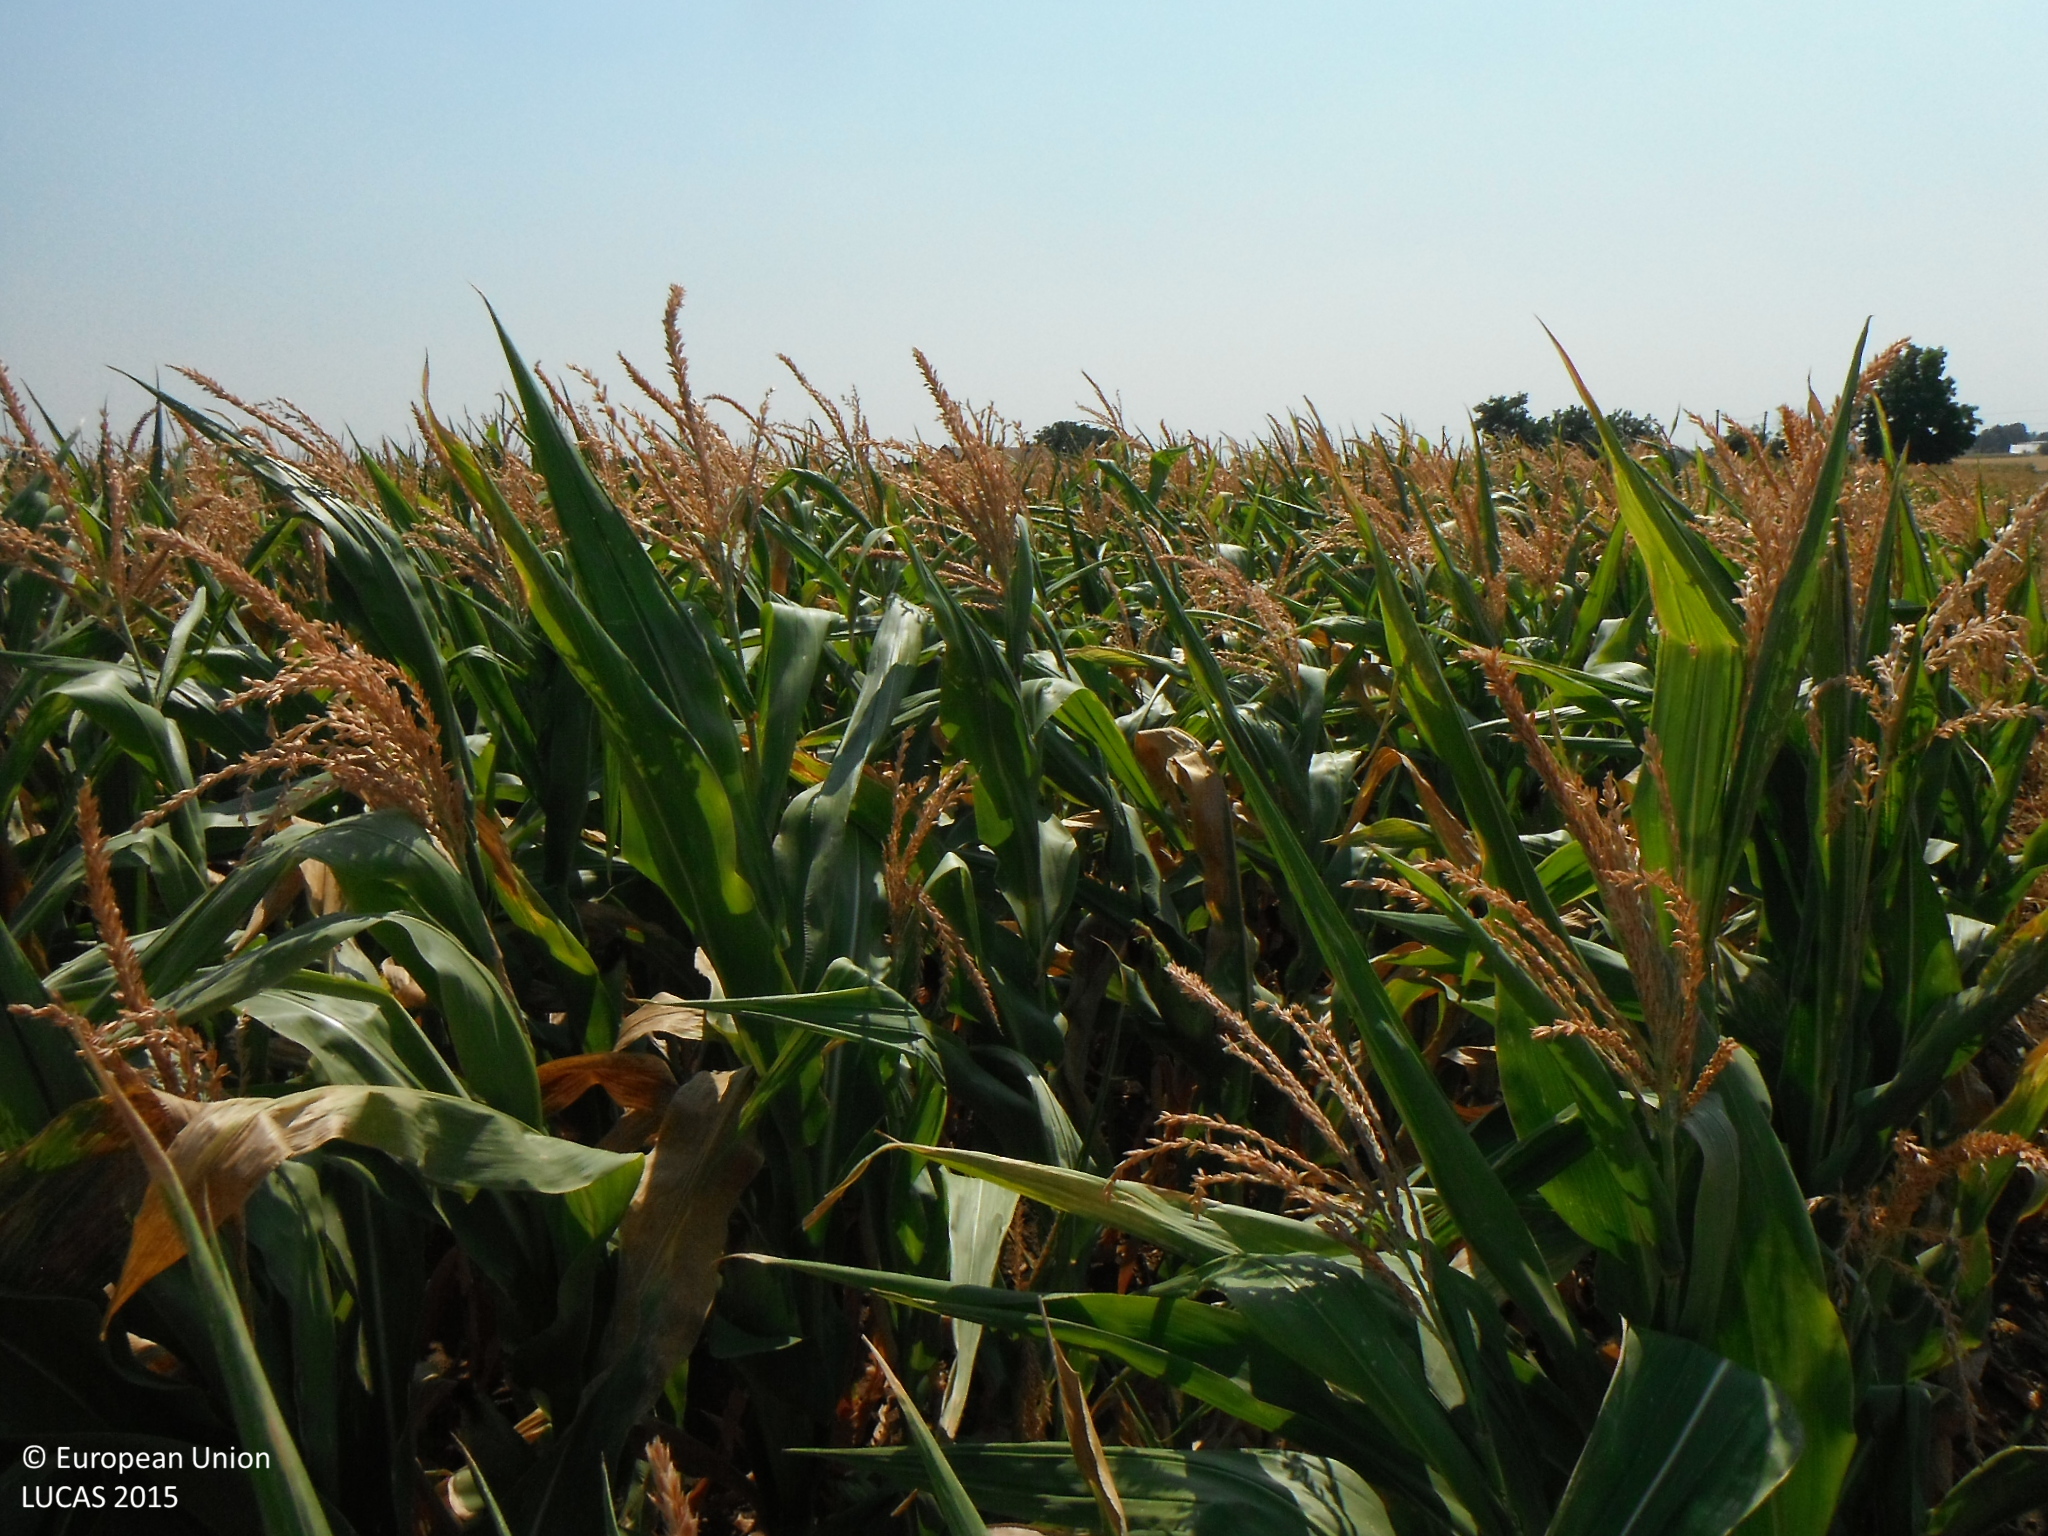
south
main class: Cropland
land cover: Maize
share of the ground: > 75 %
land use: Agriculture (excluding fallow land and kitchen gardens)
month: August
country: SK
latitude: 47.9840
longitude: 18.2808
